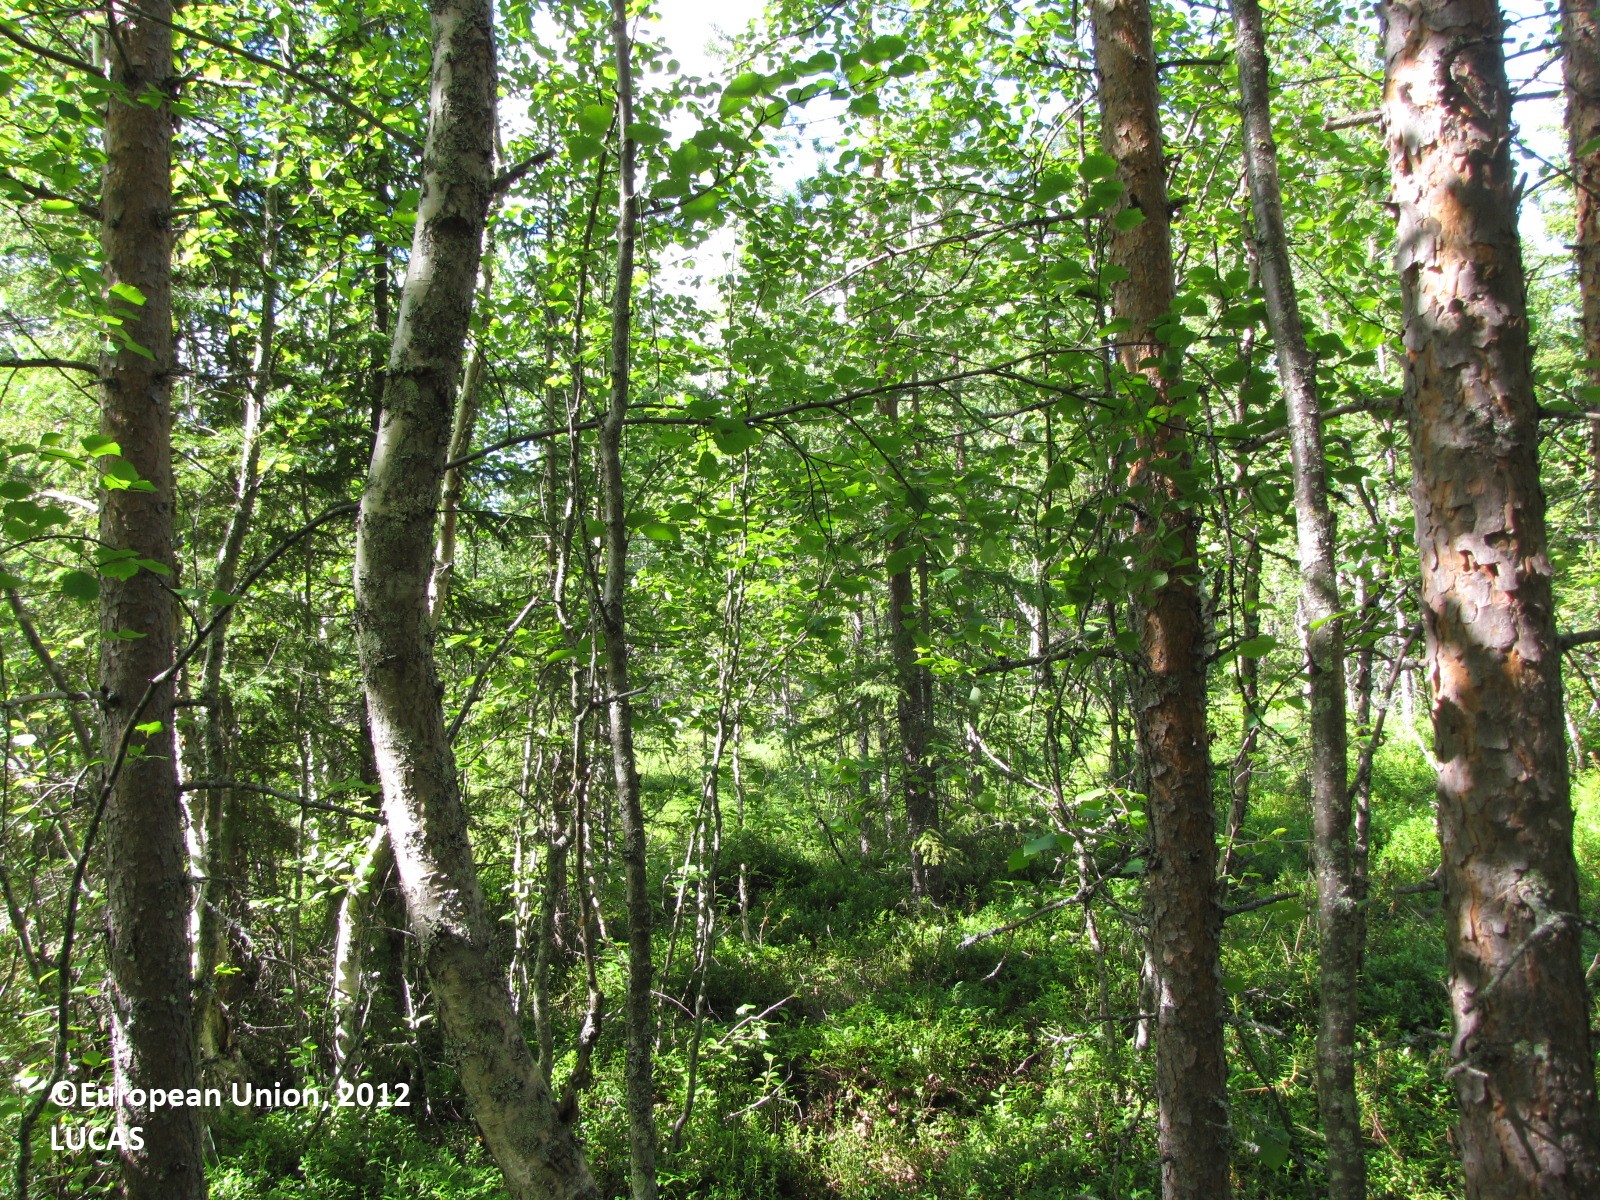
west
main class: Woodland
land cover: Other mixed woodland
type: boreal forest
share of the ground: 50 - 75 %
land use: Forestry
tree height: > 5 m
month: July
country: FI
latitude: 66.5806
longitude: 24.5878
